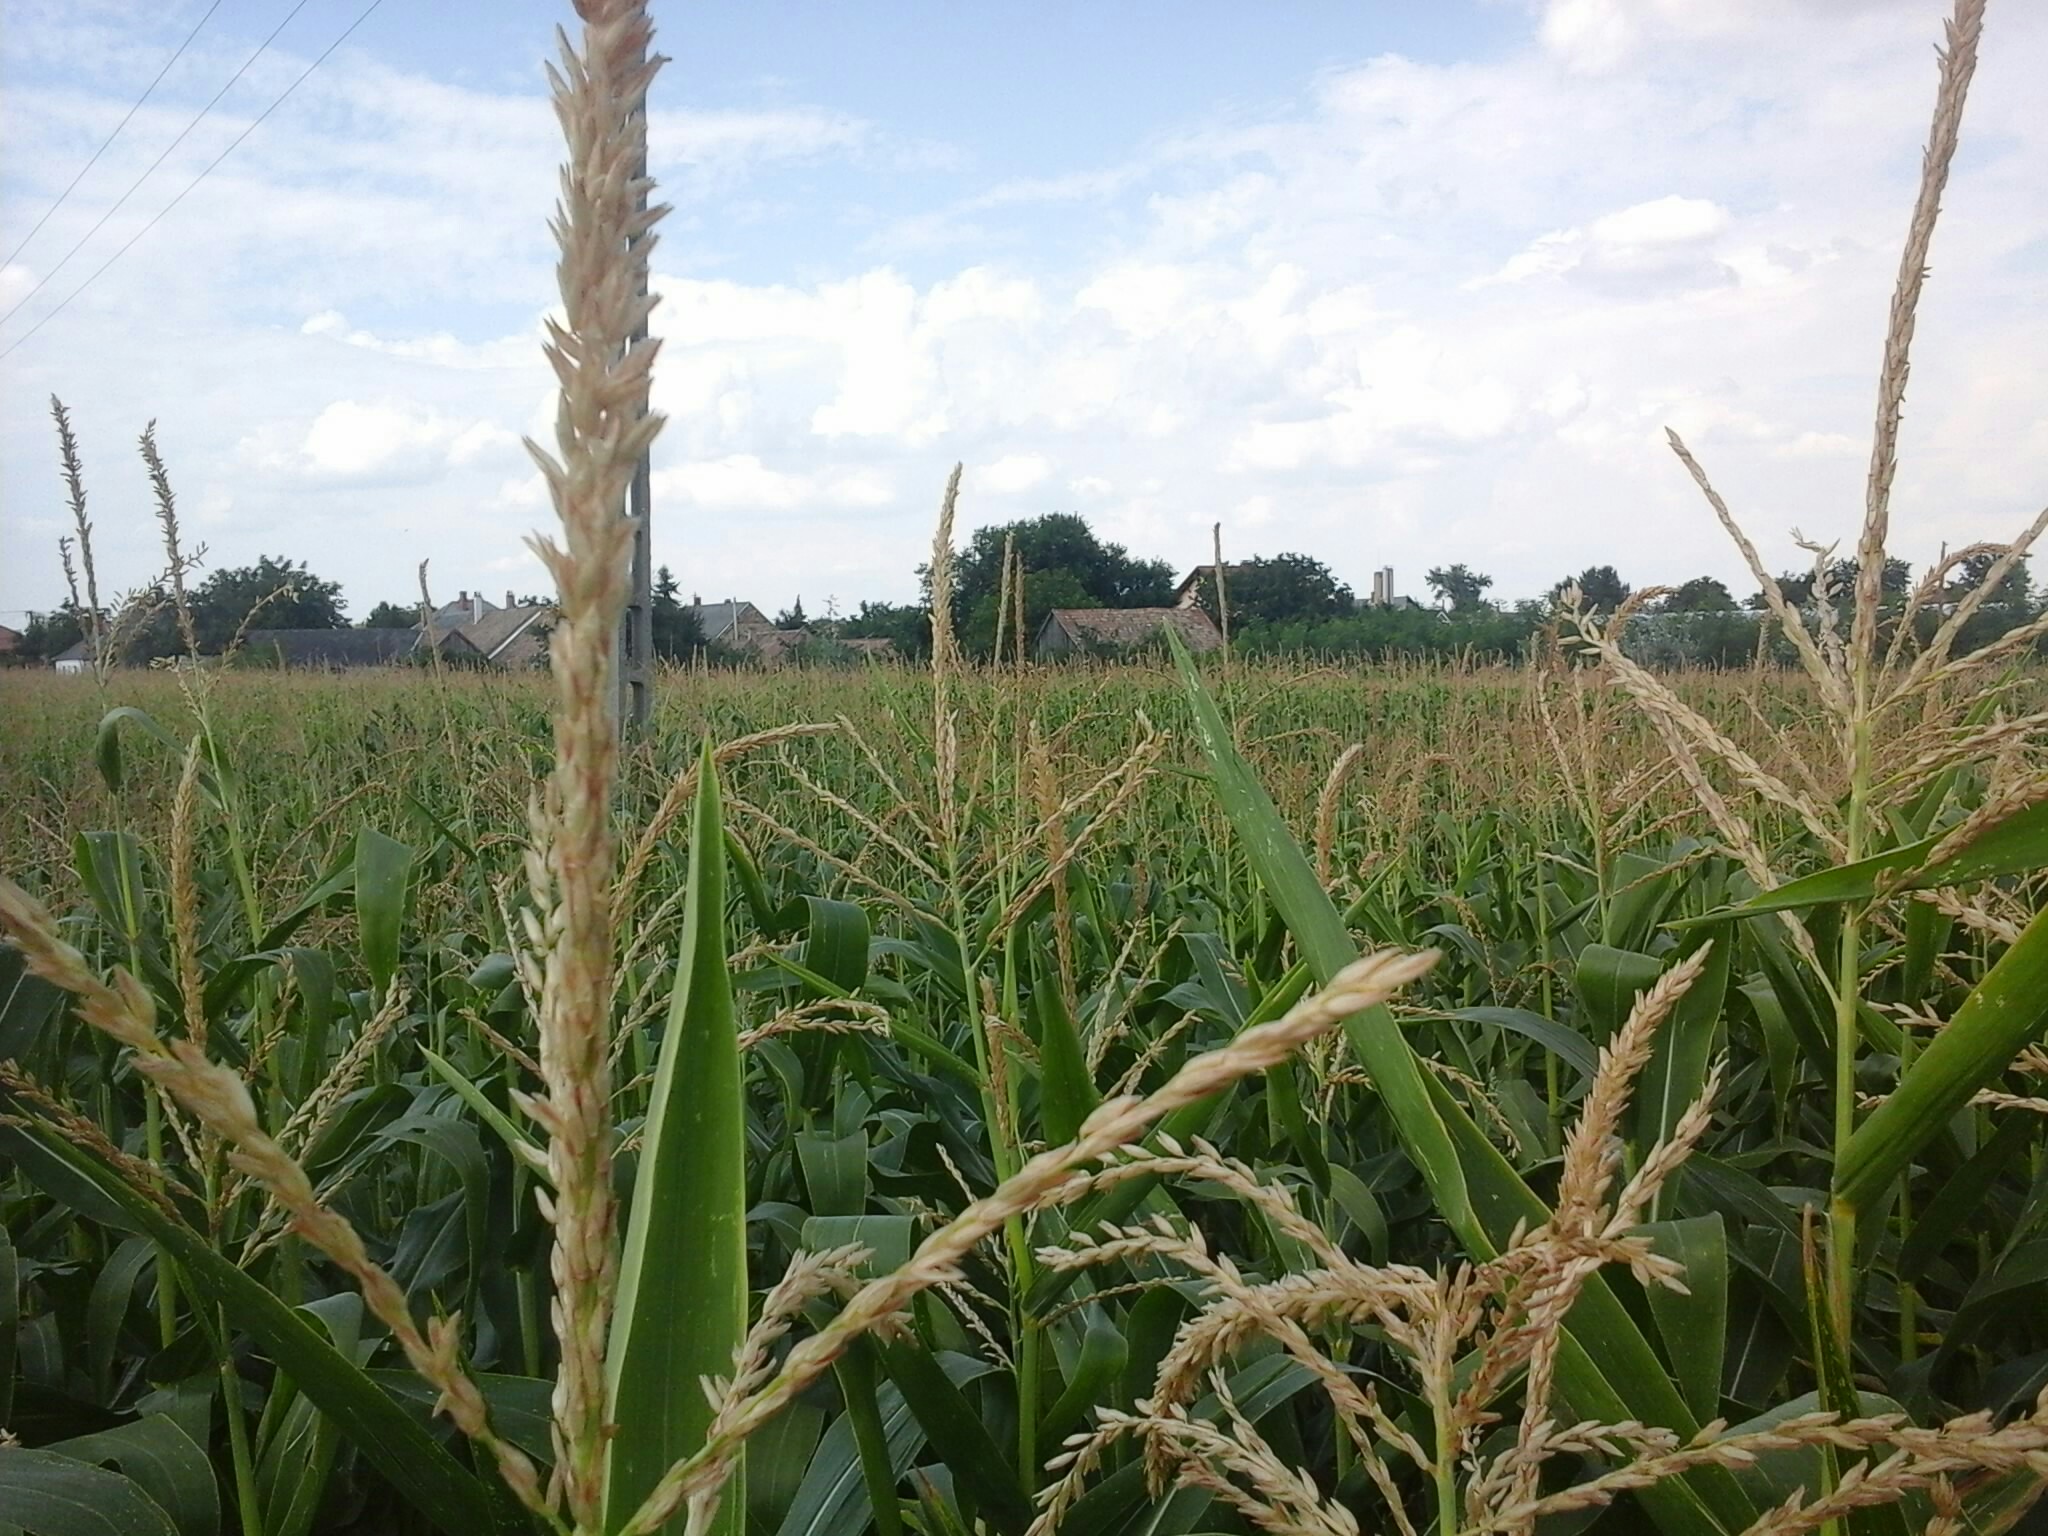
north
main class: Cropland
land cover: Maize
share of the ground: > 75 %
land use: Agriculture (excluding fallow land and kitchen gardens)
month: August
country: HU
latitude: 47.5054
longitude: 18.1502
